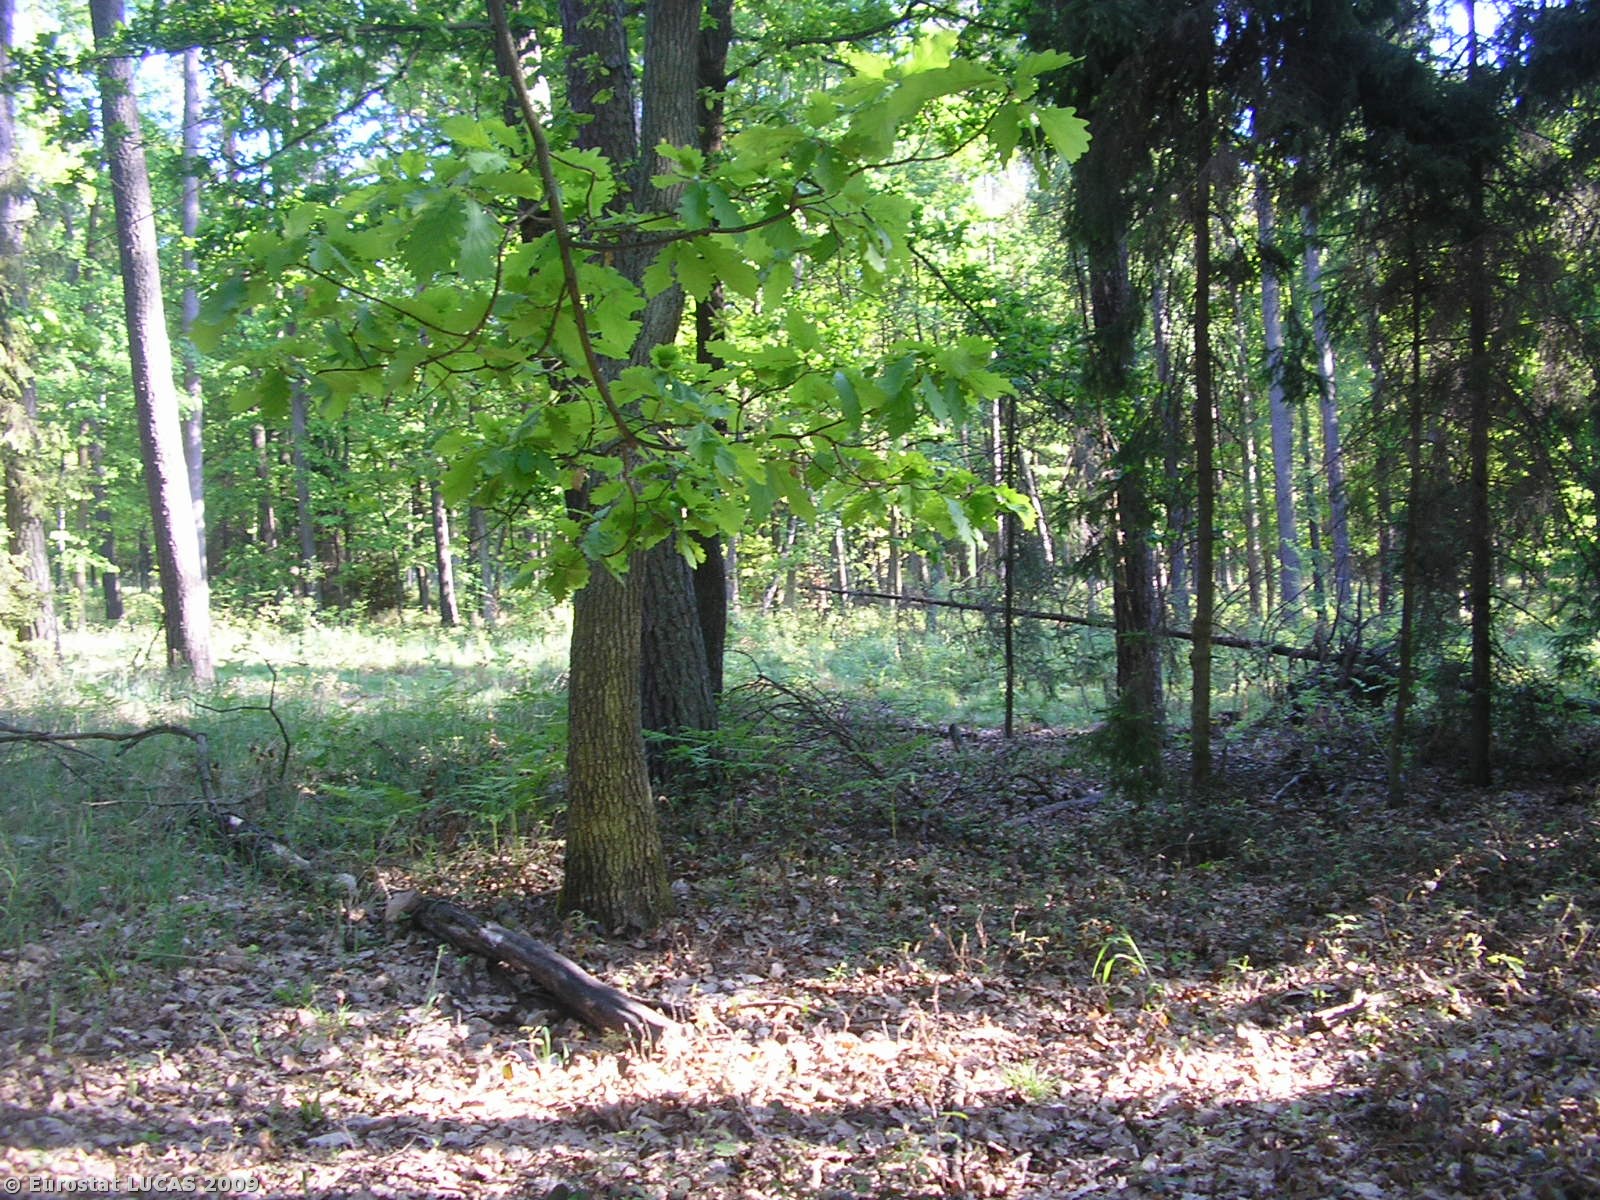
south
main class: Woodland
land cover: Mixed woodland
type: hemiboreal forest and nemoral coniferous forest and mixed broadleaved-coniferous forest
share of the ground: > 75 %
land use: Forestry
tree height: > 5 m
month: May
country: PL
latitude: 51.6292
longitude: 19.9863
